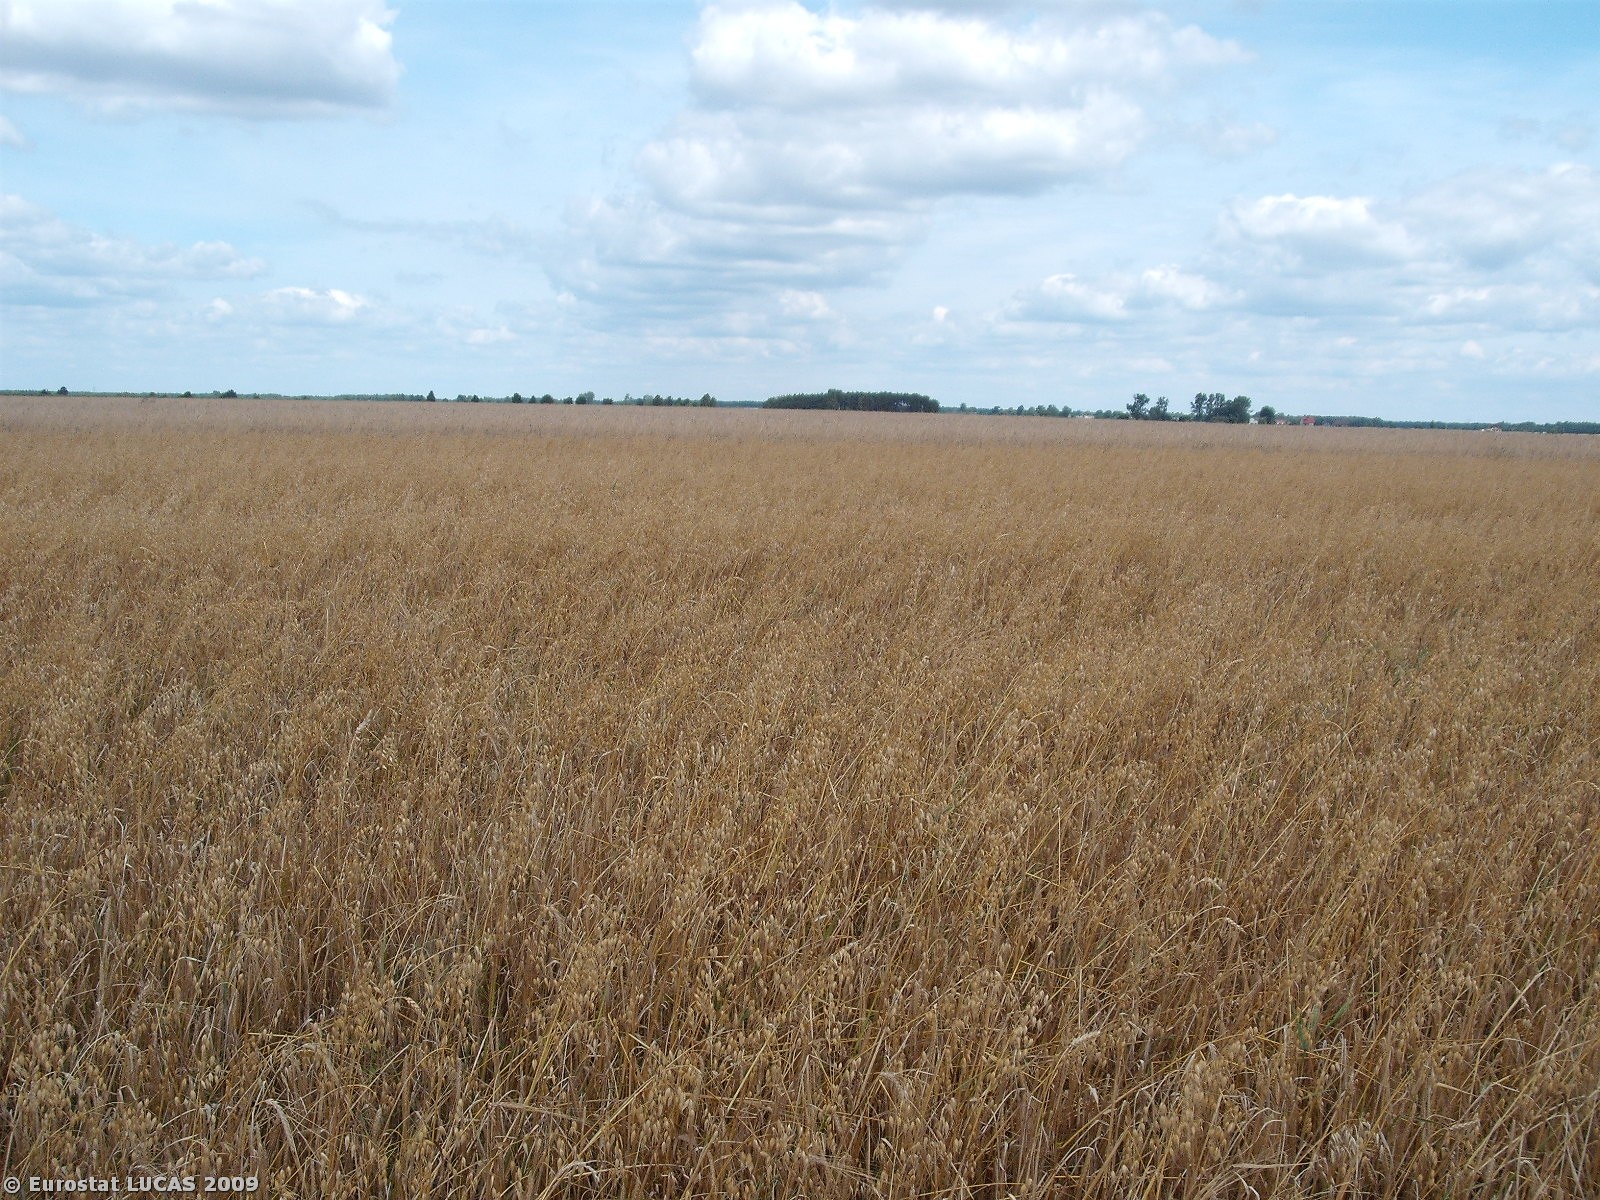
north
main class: Cropland
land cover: Barley
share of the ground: 50 - 75 %
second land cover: Oats
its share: 25 - 50 %
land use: Agriculture (excluding fallow land and kitchen gardens)
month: July
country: PL
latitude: 51.3178
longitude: 21.3992
